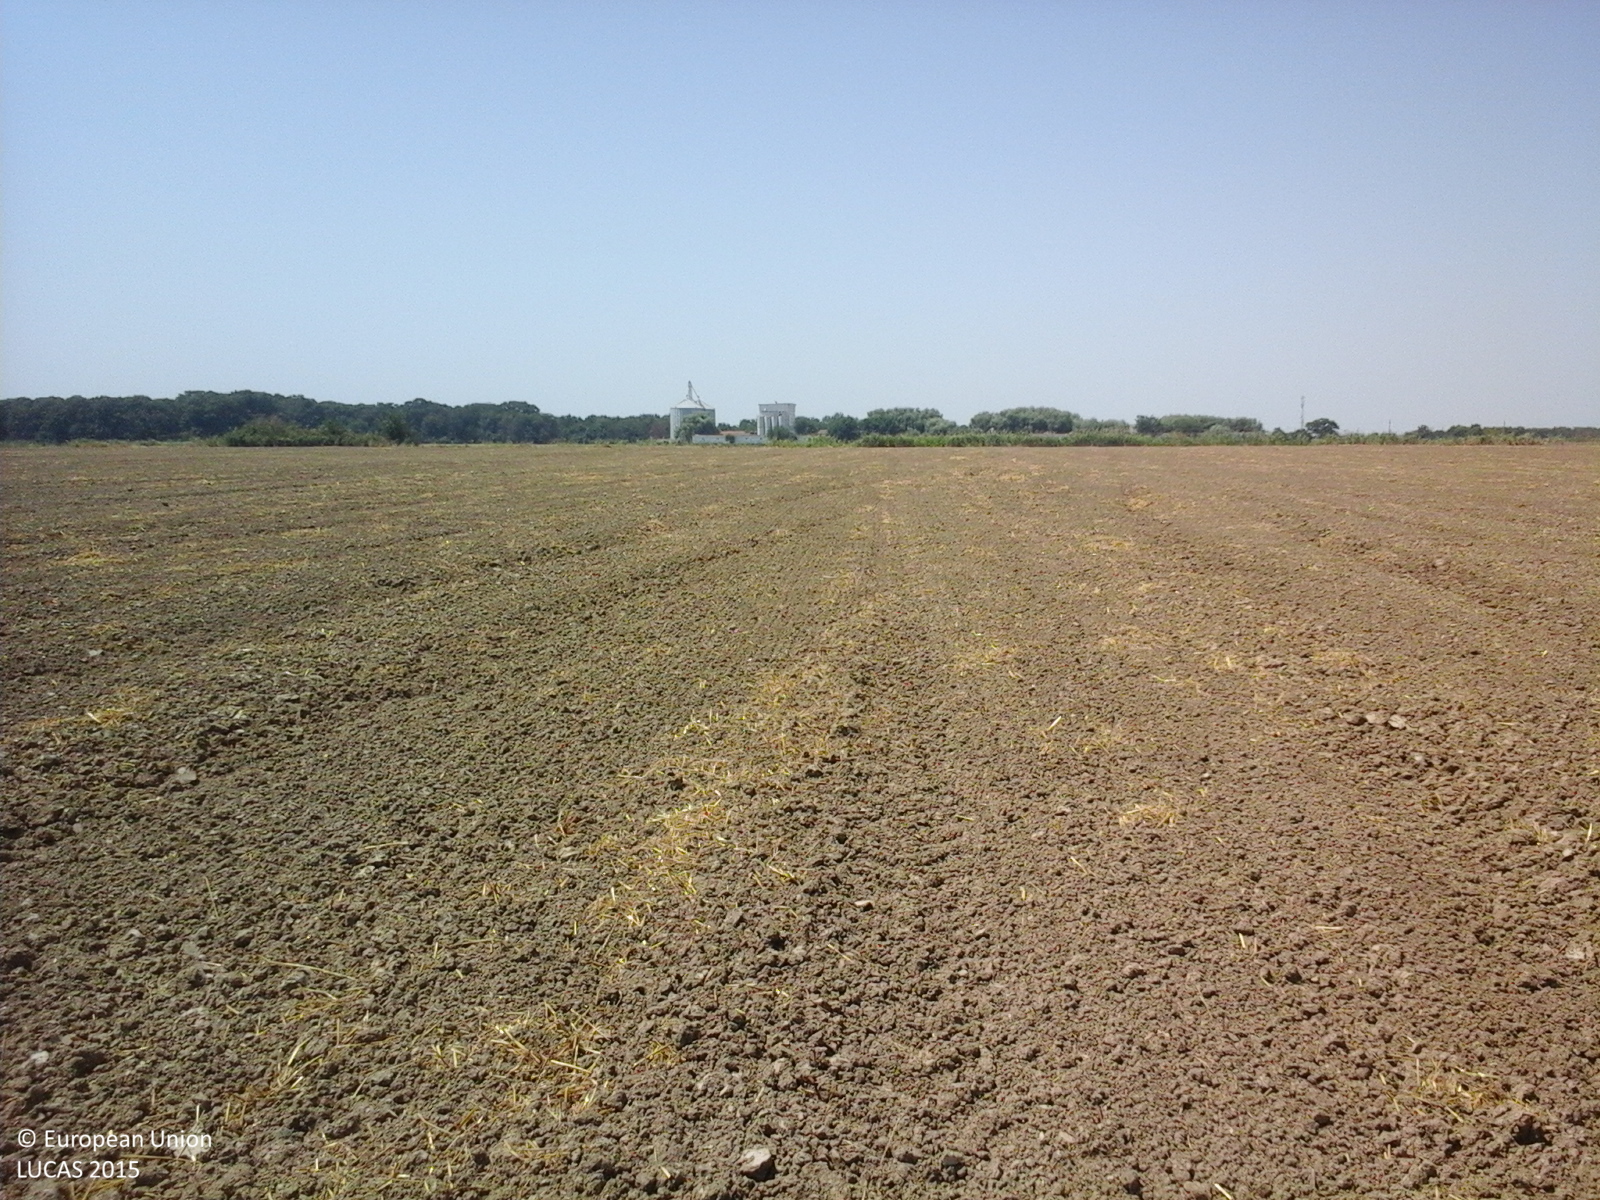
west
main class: Cropland
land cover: Common wheat
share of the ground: < 10 %
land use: Agriculture (excluding fallow land and kitchen gardens)
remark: Harvested field
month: July
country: RO
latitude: 44.5640
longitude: 27.2732
